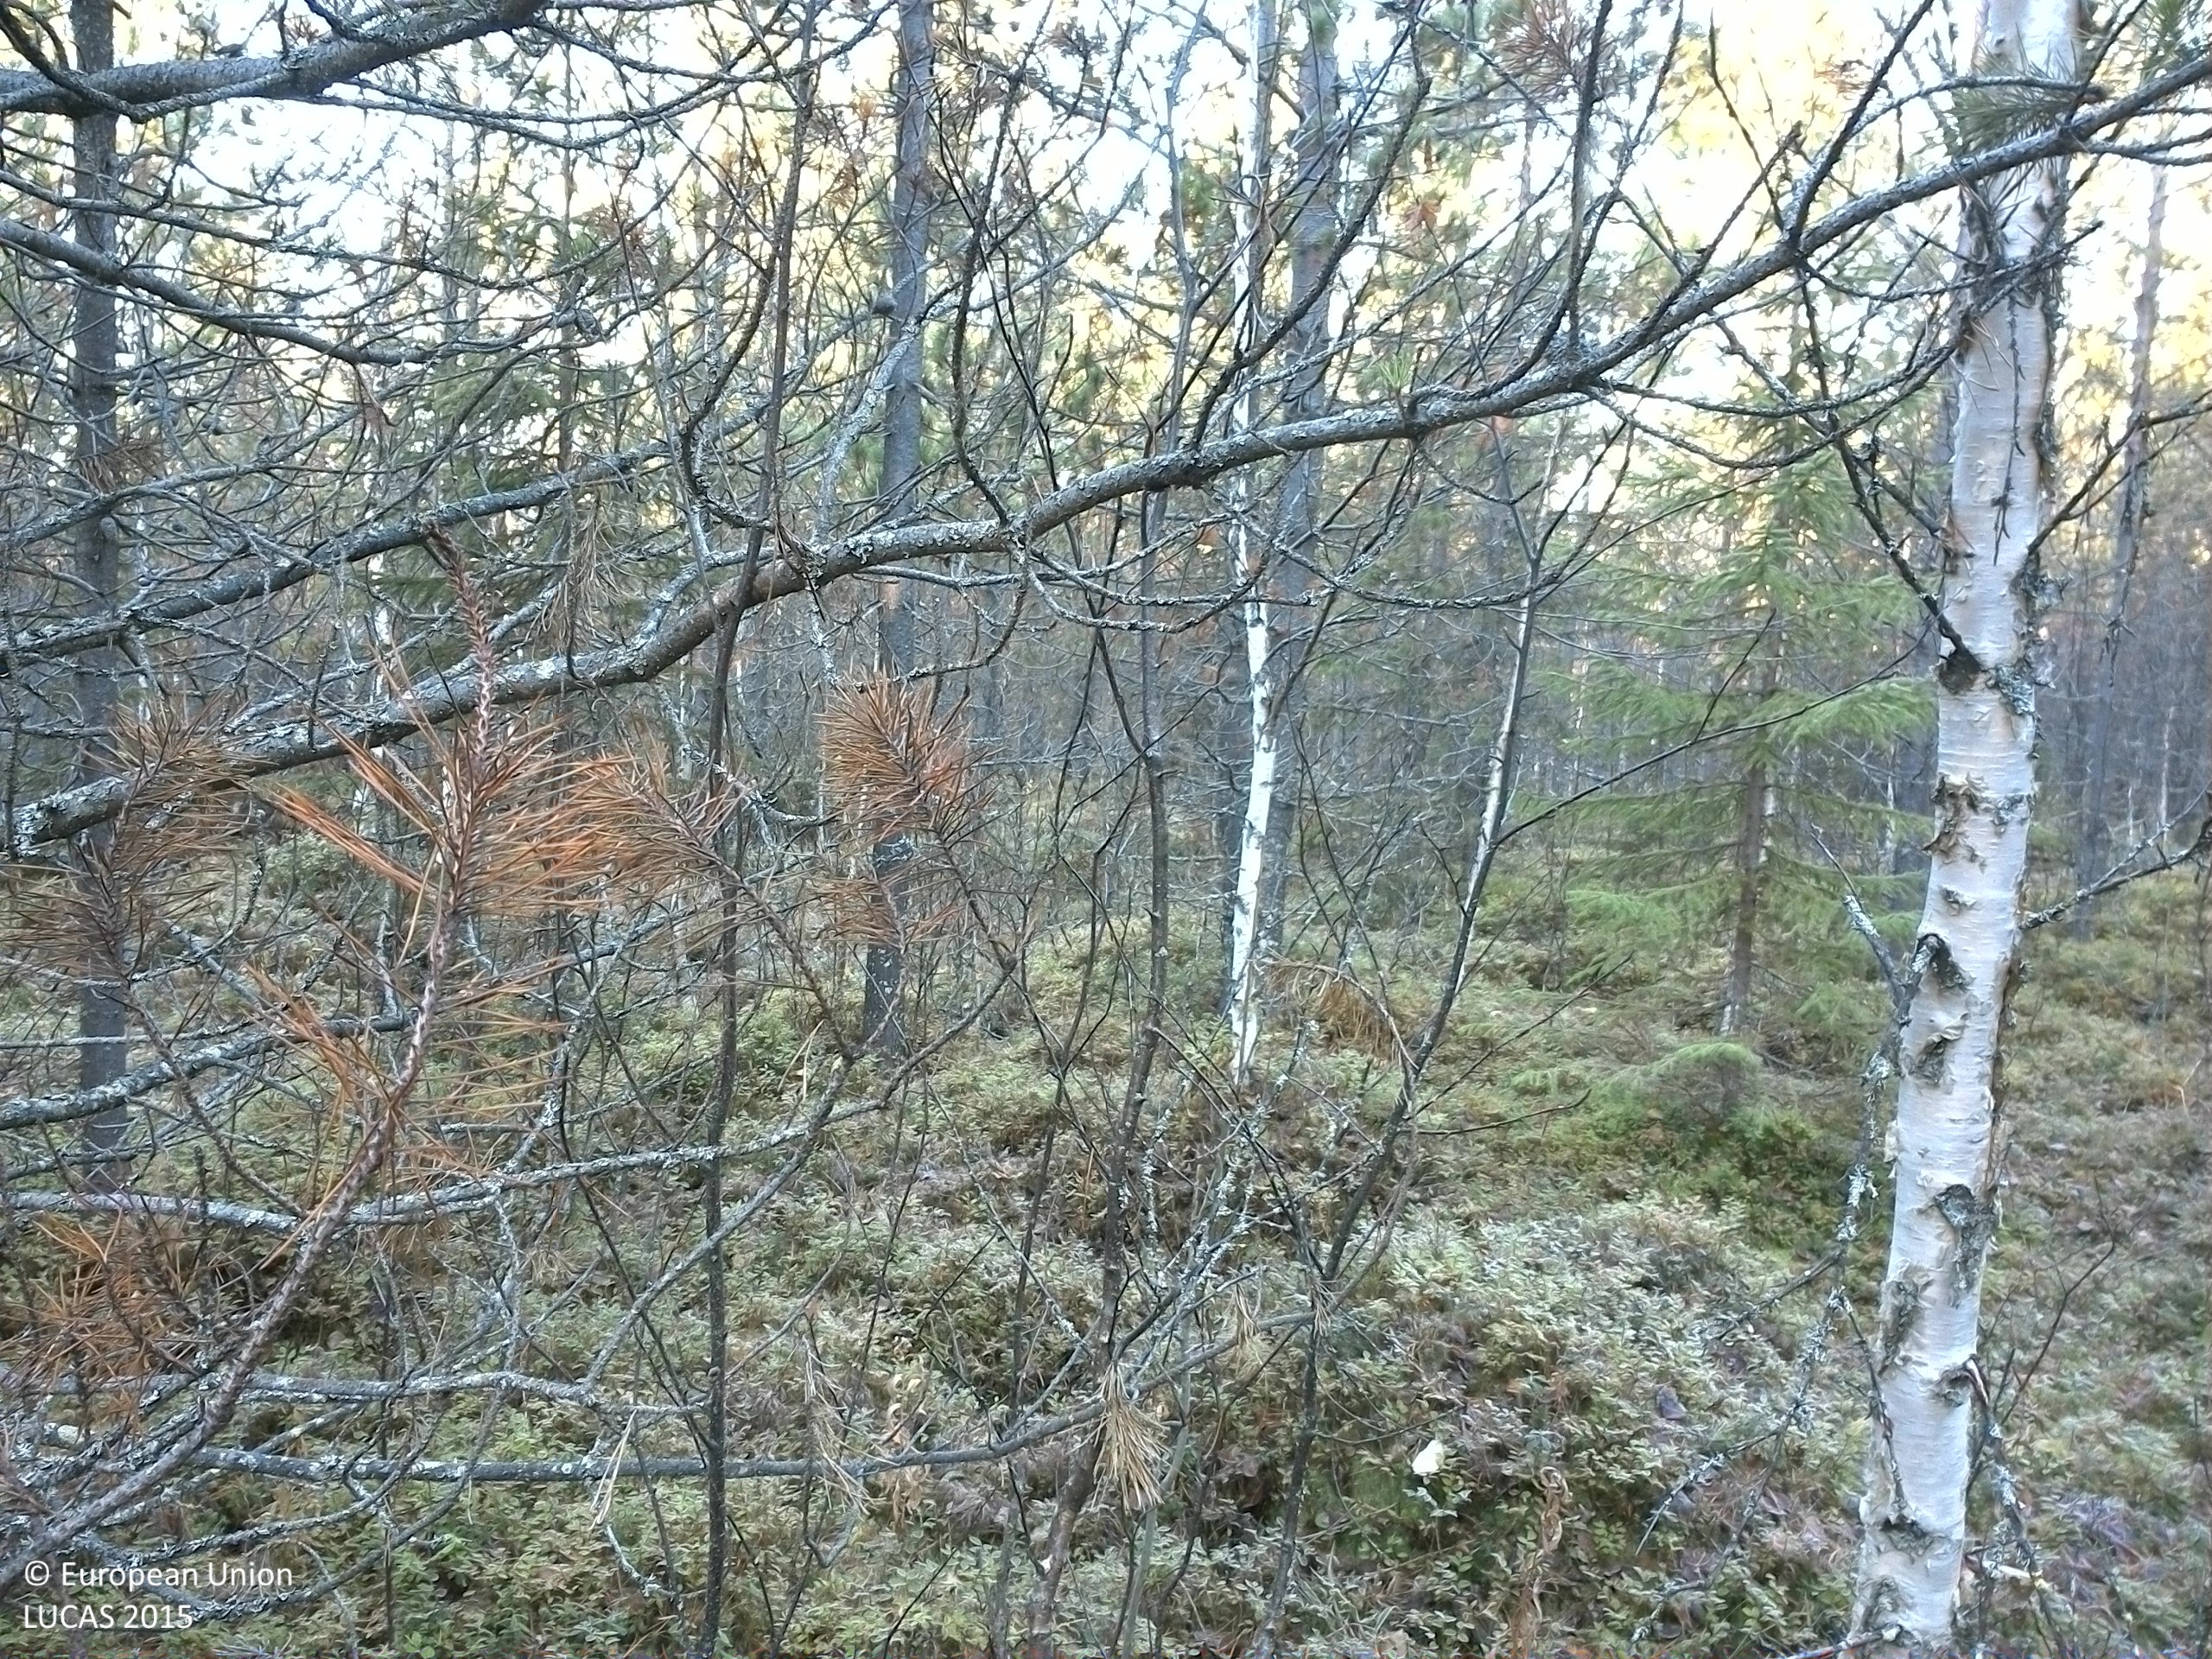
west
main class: Woodland
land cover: Pine dominated mixed woodland
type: exotic forest
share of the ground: 50 - 75 %
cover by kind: coniferous forest trees 40 %, shrubs 35 %, broadleaved forest trees 15 %, lichens and mosses 10 %
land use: Forestry
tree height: > 5 m
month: October
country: SE
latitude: 64.5549
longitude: 15.5394
